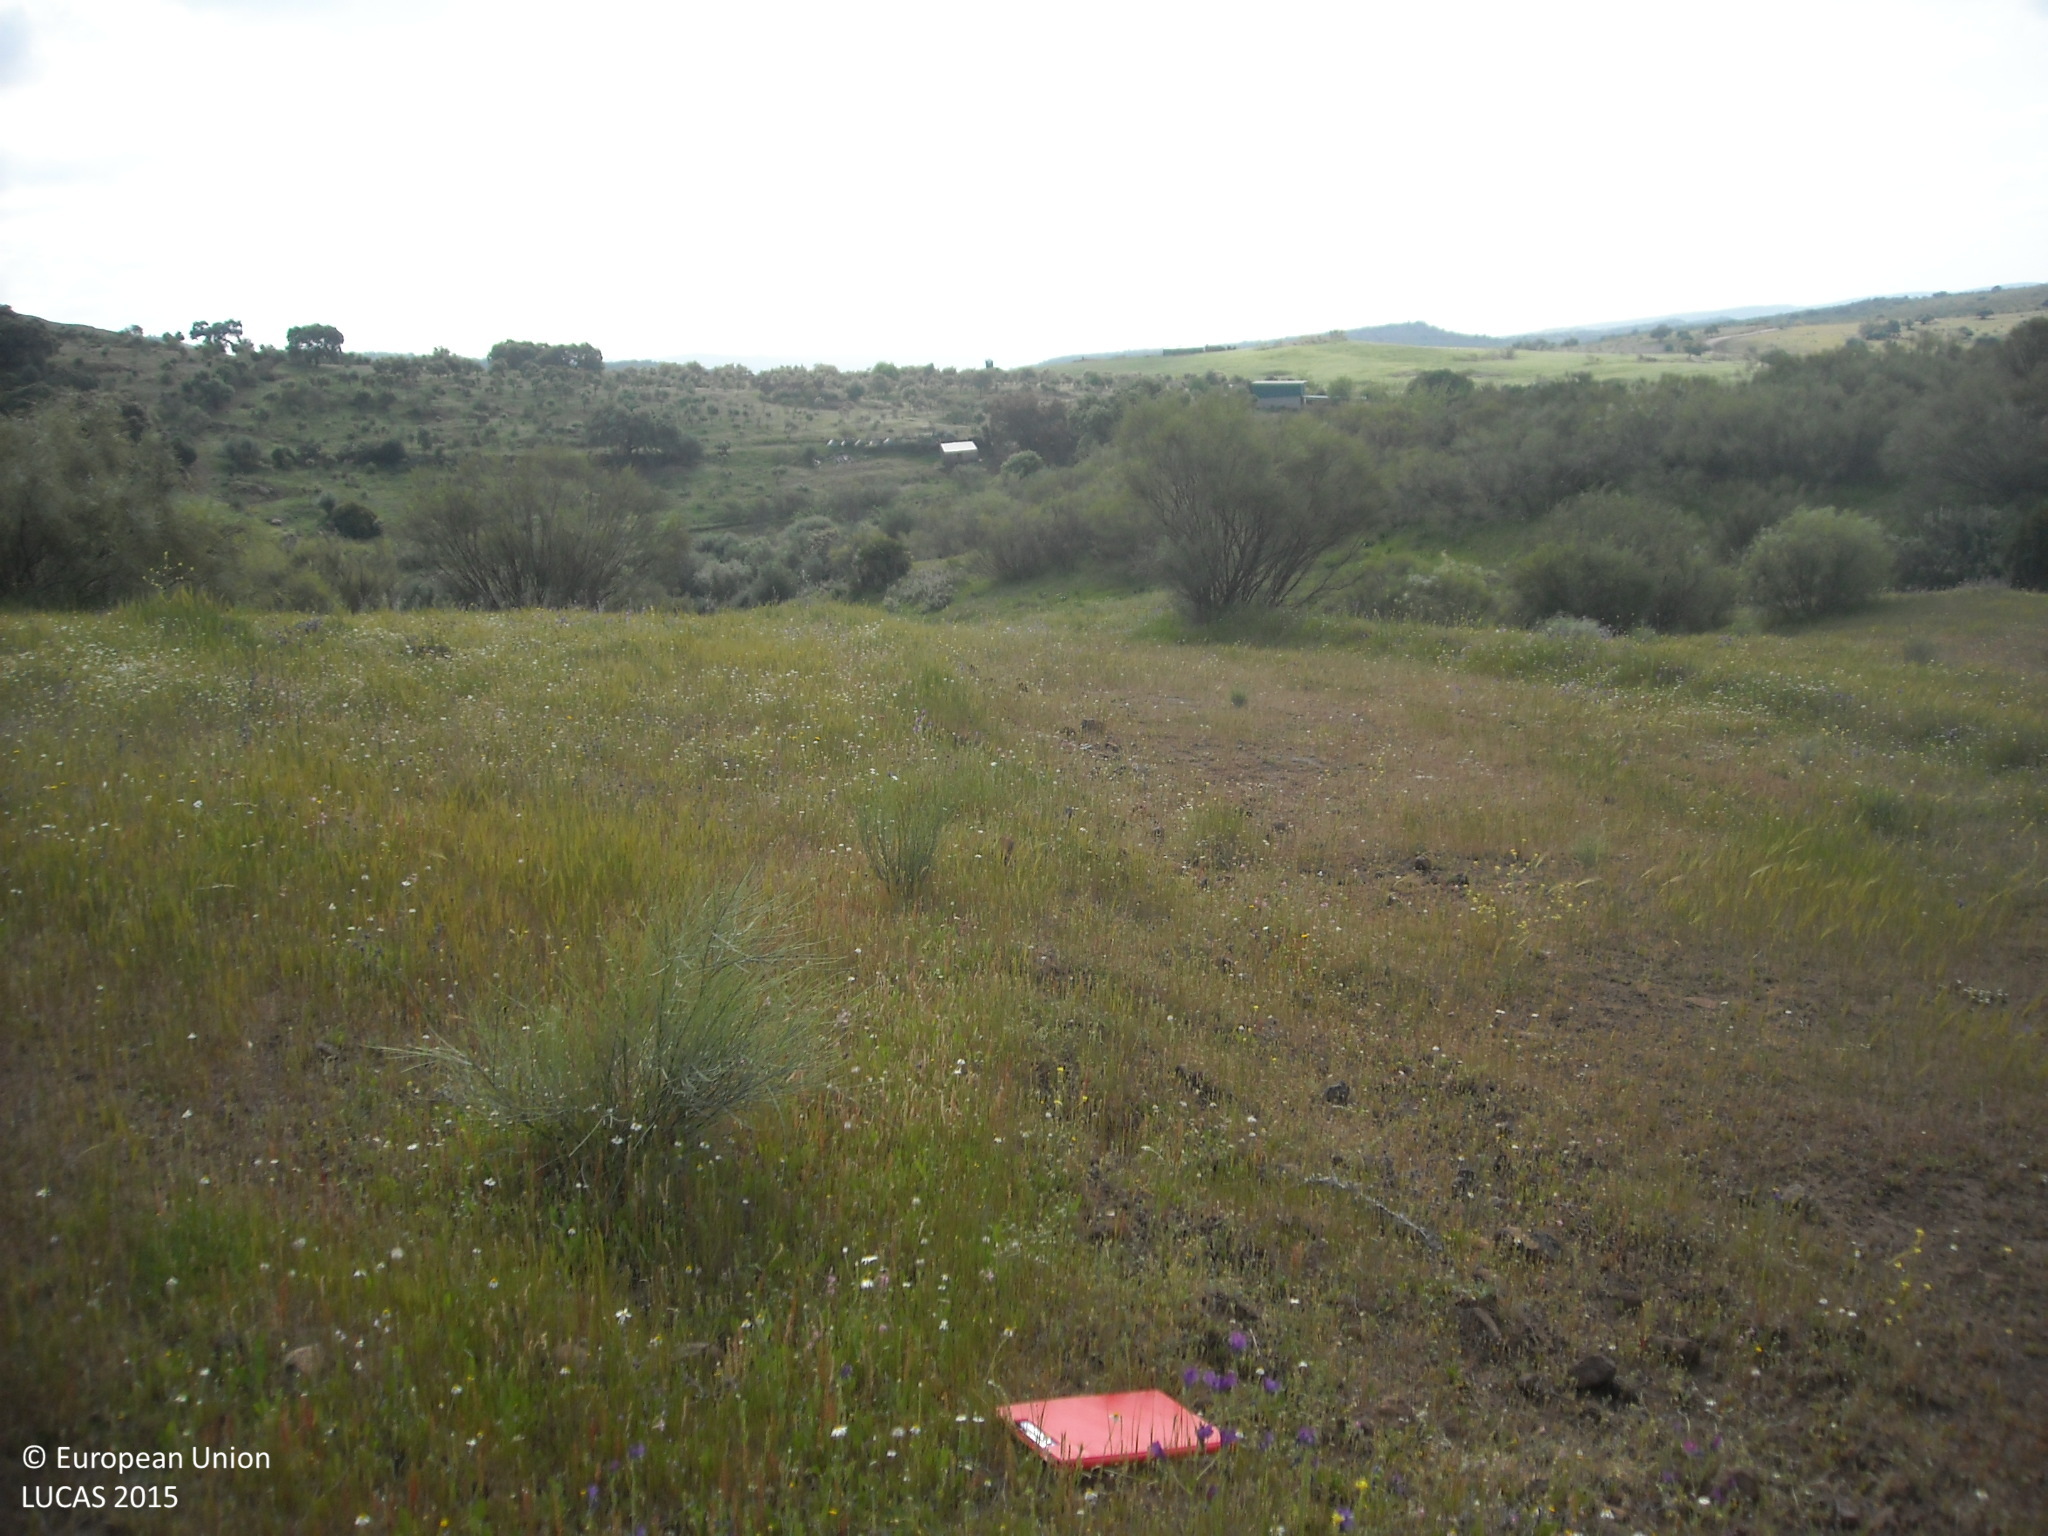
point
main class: Grassland
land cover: Grassland without tree/shrub cover
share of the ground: 50 - 75 %
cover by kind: herbaceous plants 70 %, consolidated bare surface 30 %
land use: Agriculture (excluding fallow land and kitchen gardens)
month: April
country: ES
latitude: 37.8578
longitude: -6.0019
